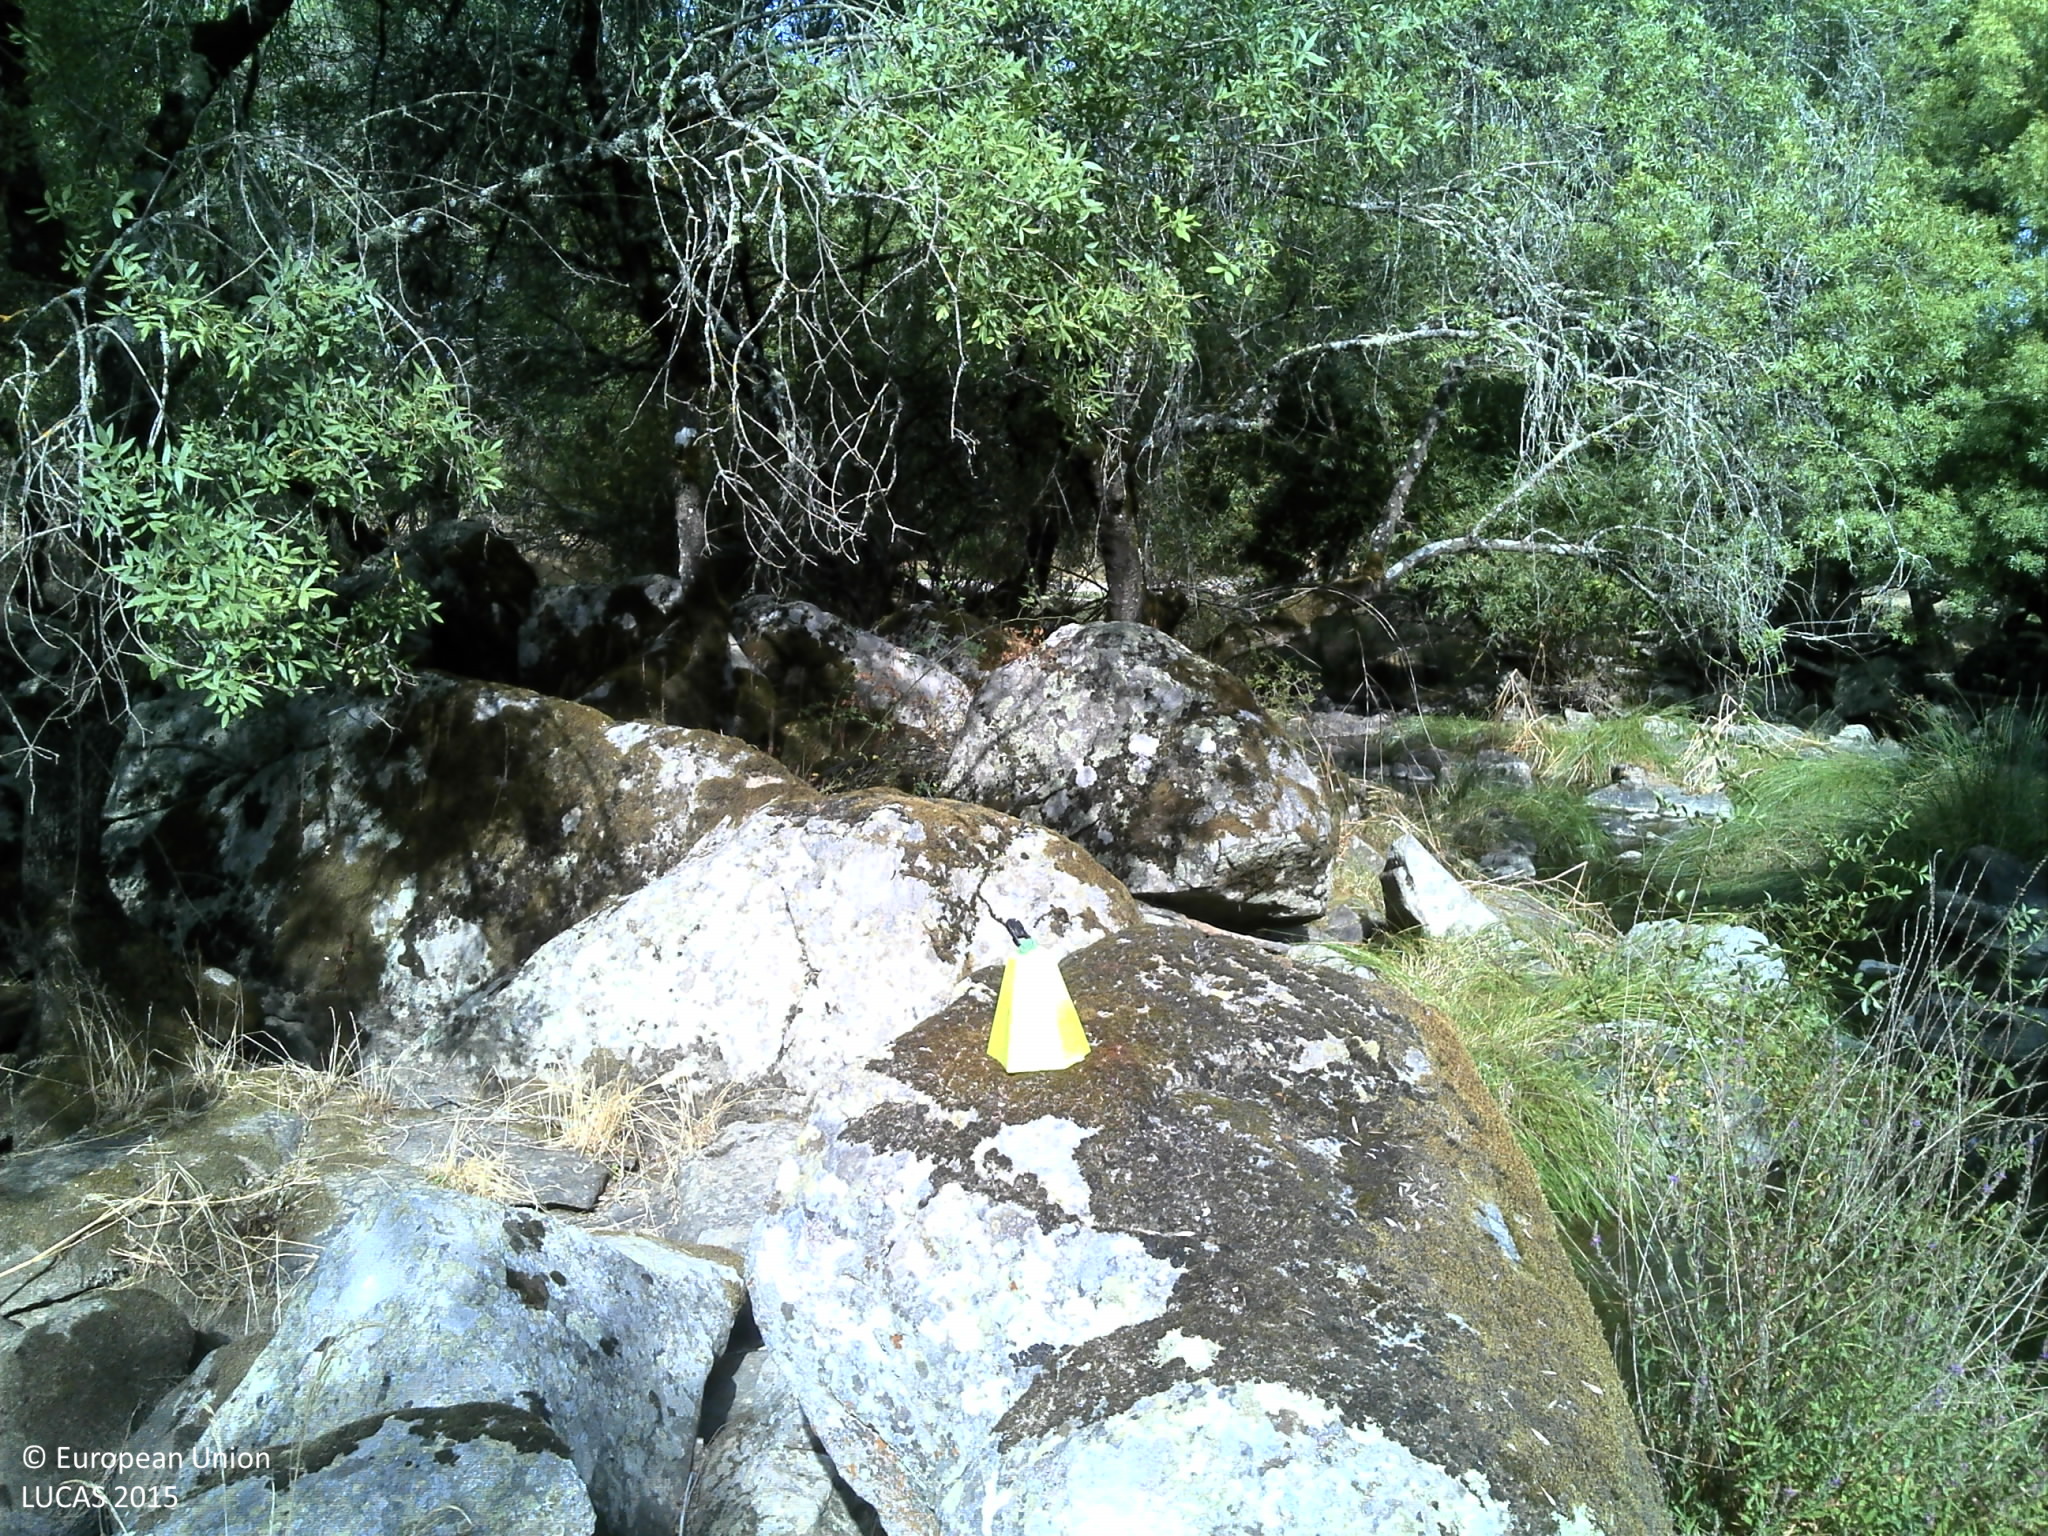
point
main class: Woodland
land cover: Broadleaved woodland
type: broadleaved evergreen forest
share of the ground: > 75 %
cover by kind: broadleaved forest trees 75 %, consolidated bare surface 25 %
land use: Forestry
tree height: > 5 m
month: August
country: PT
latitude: 39.2612
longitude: -7.5555
